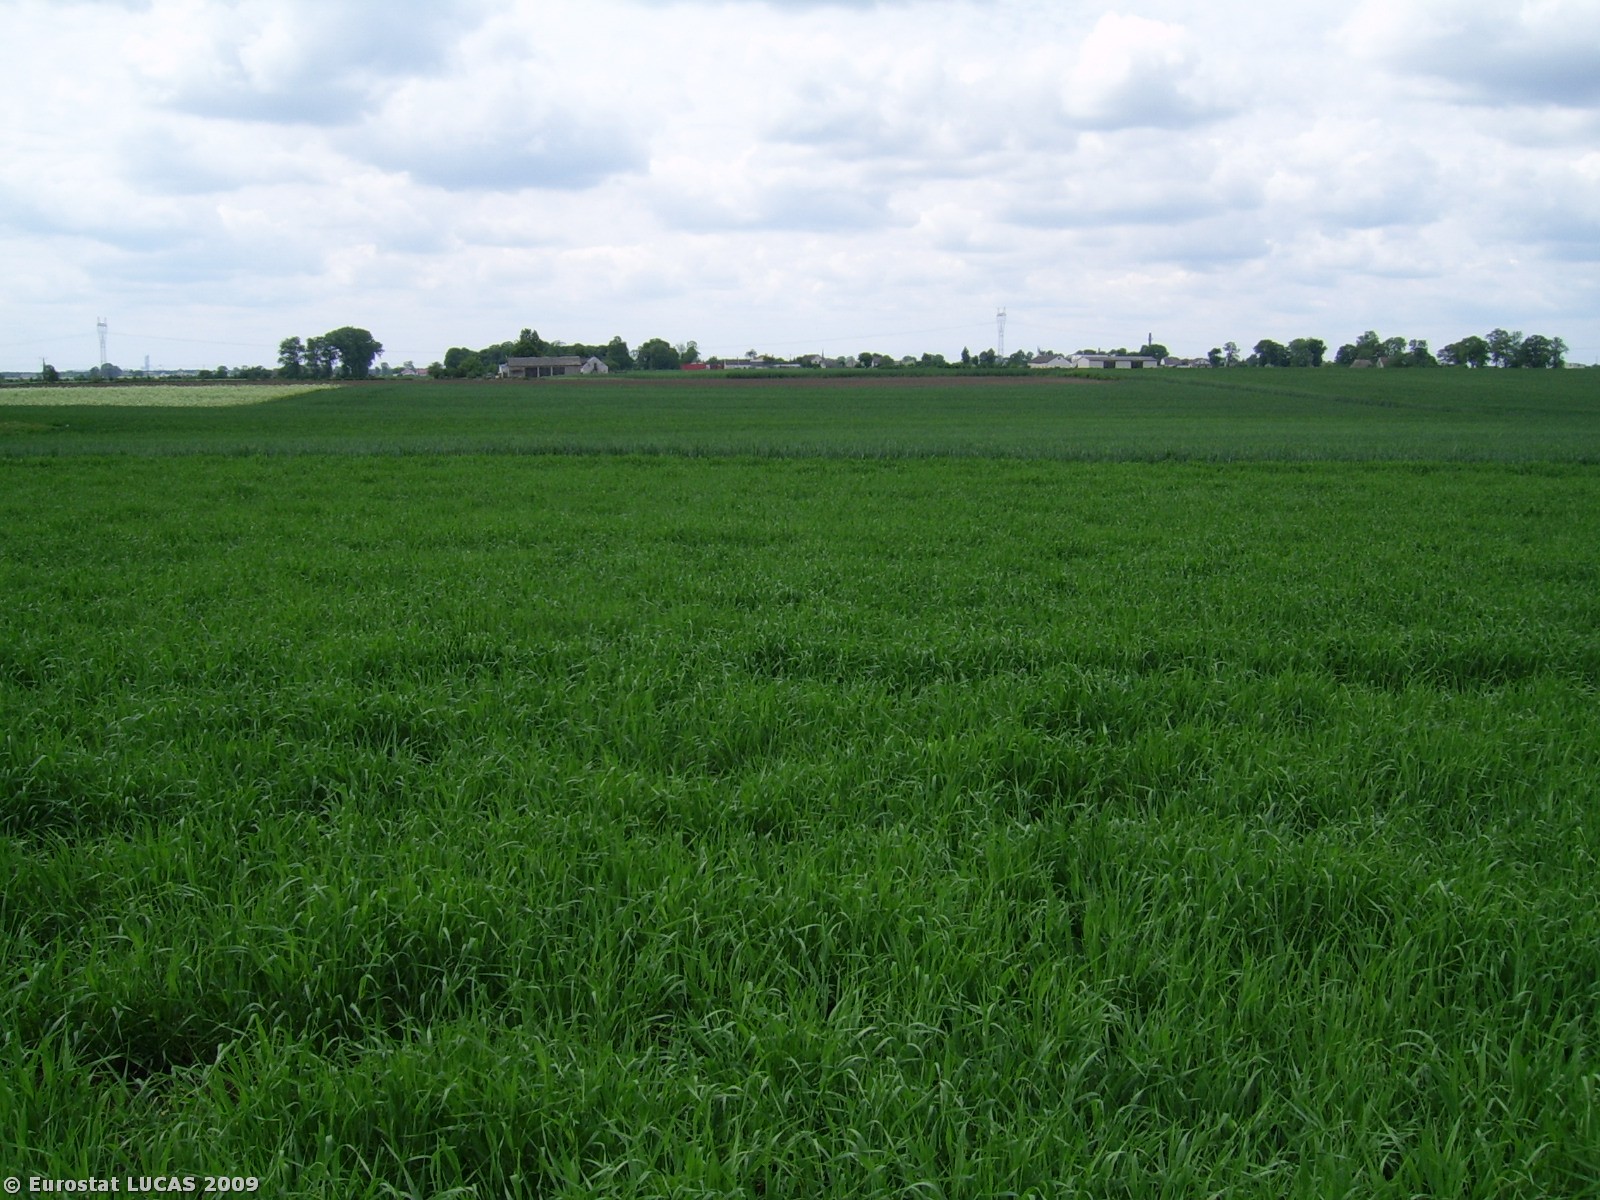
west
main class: Cropland
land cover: Barley
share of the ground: > 75 %
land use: Agriculture (excluding fallow land and kitchen gardens)
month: May
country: PL
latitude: 52.8546
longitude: 18.1695
